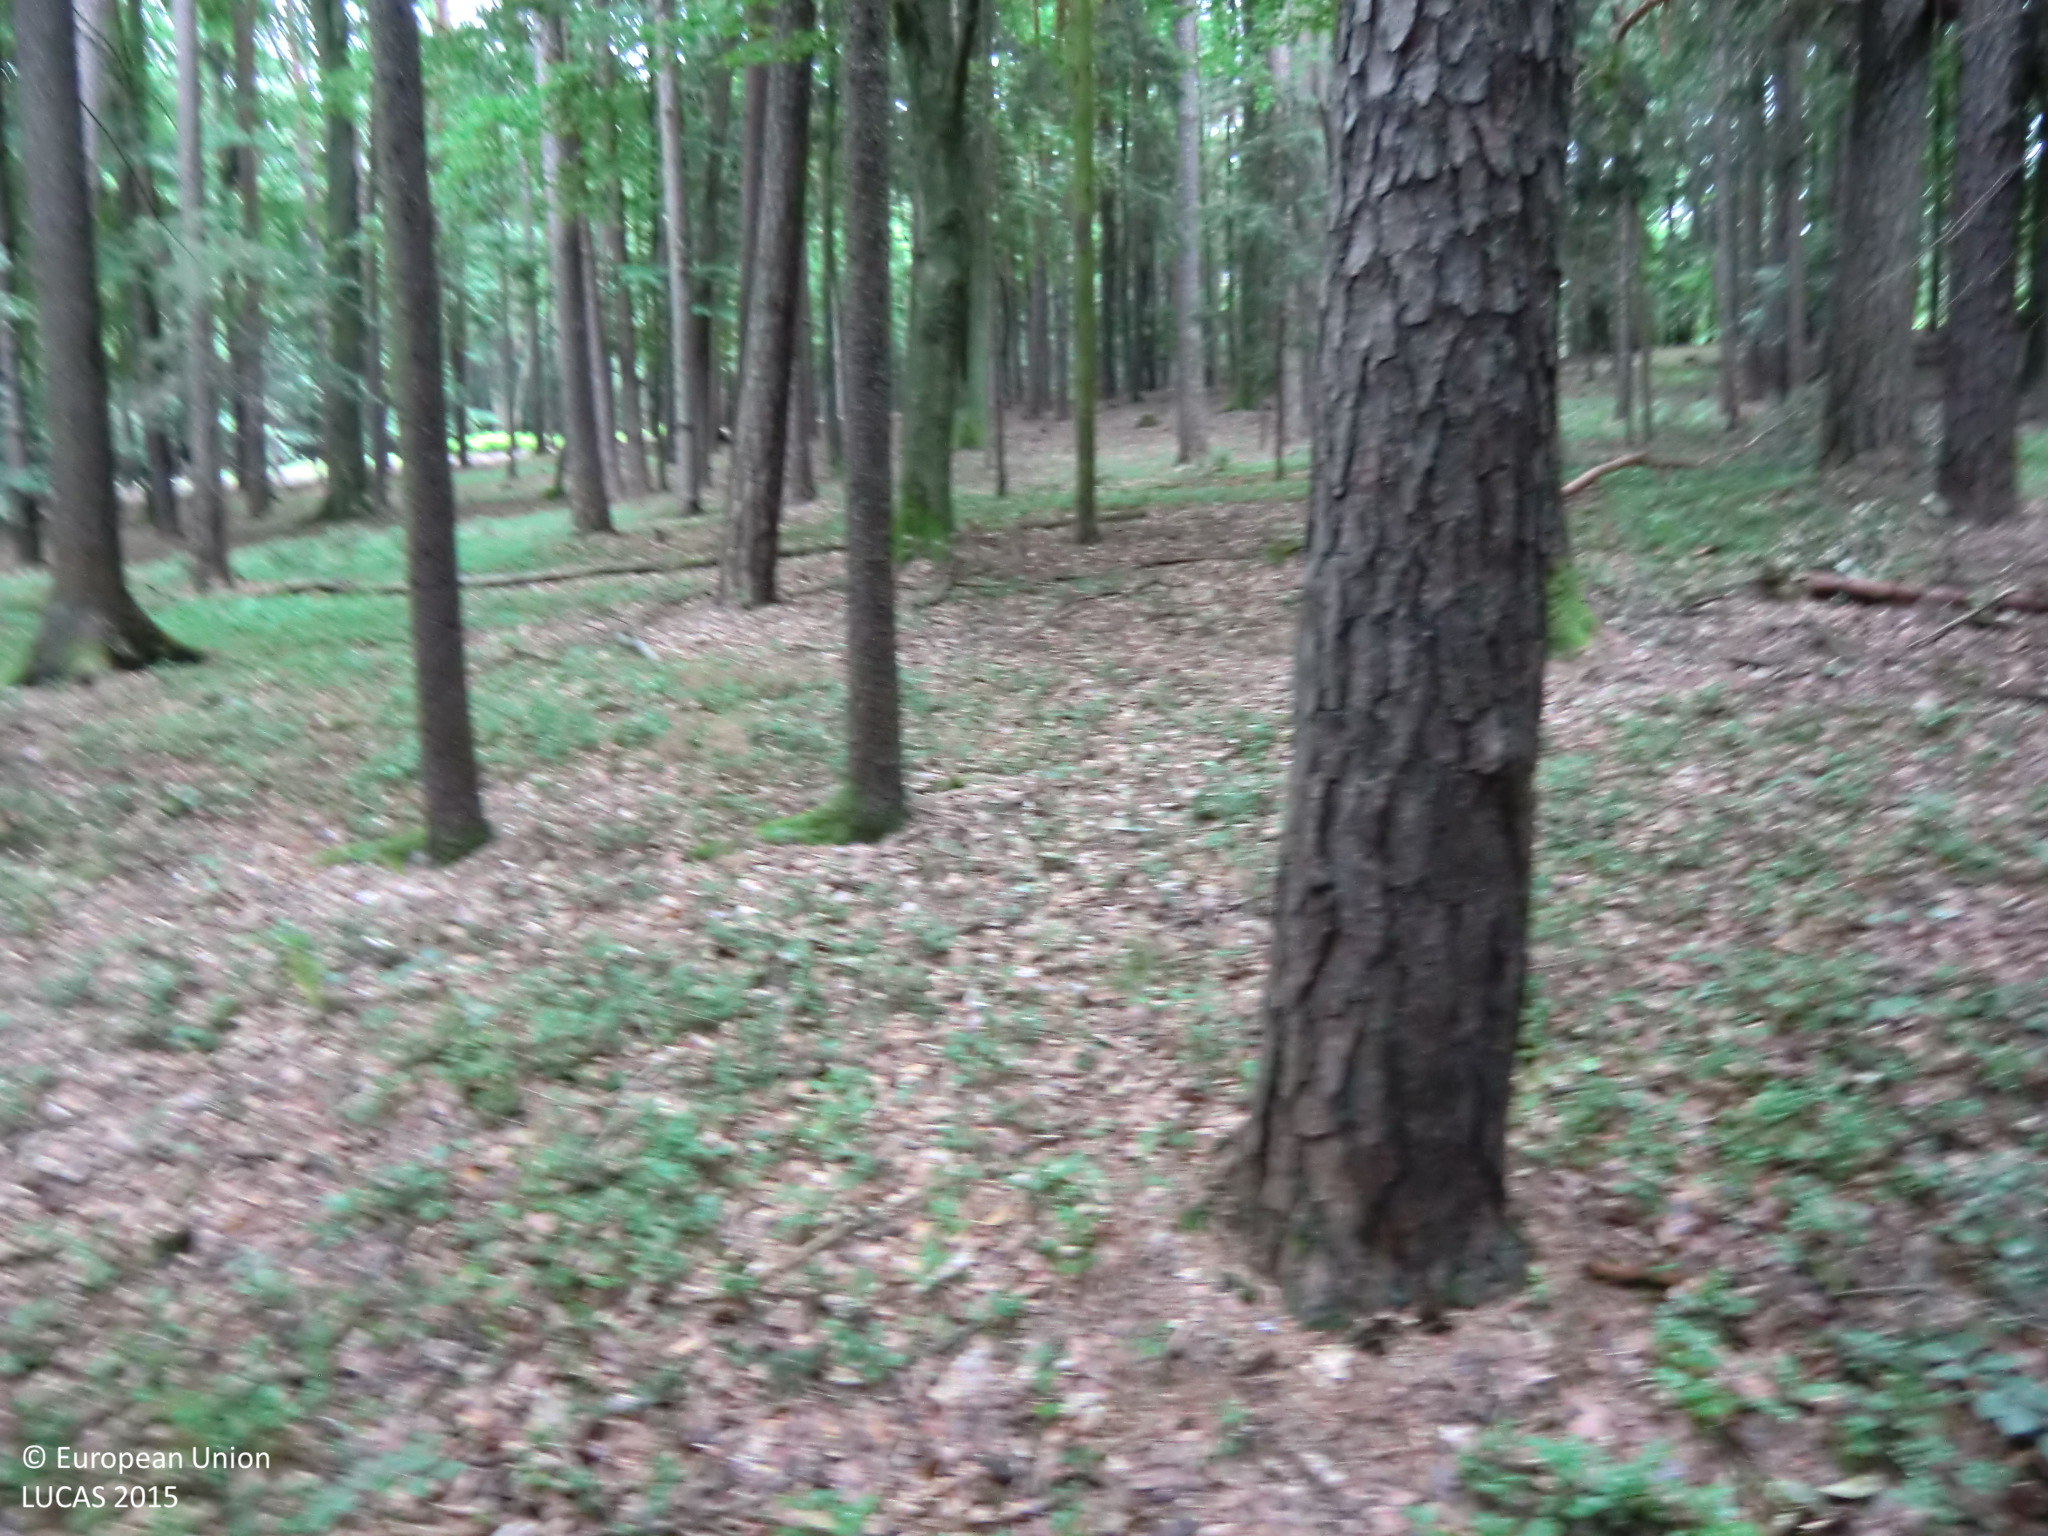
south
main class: Woodland
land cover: Pine dominated mixed woodland
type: hemiboreal forest and nemoral coniferous forest and mixed broadleaved-coniferous forest
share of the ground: > 75 %
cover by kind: coniferous forest trees 40 %, broadleaved forest trees 40 %, shrubs 10 %, unconsolidated bare surface 10 %
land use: Forestry
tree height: > 5 m
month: June
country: AT
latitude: 47.1576
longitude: 16.0028
